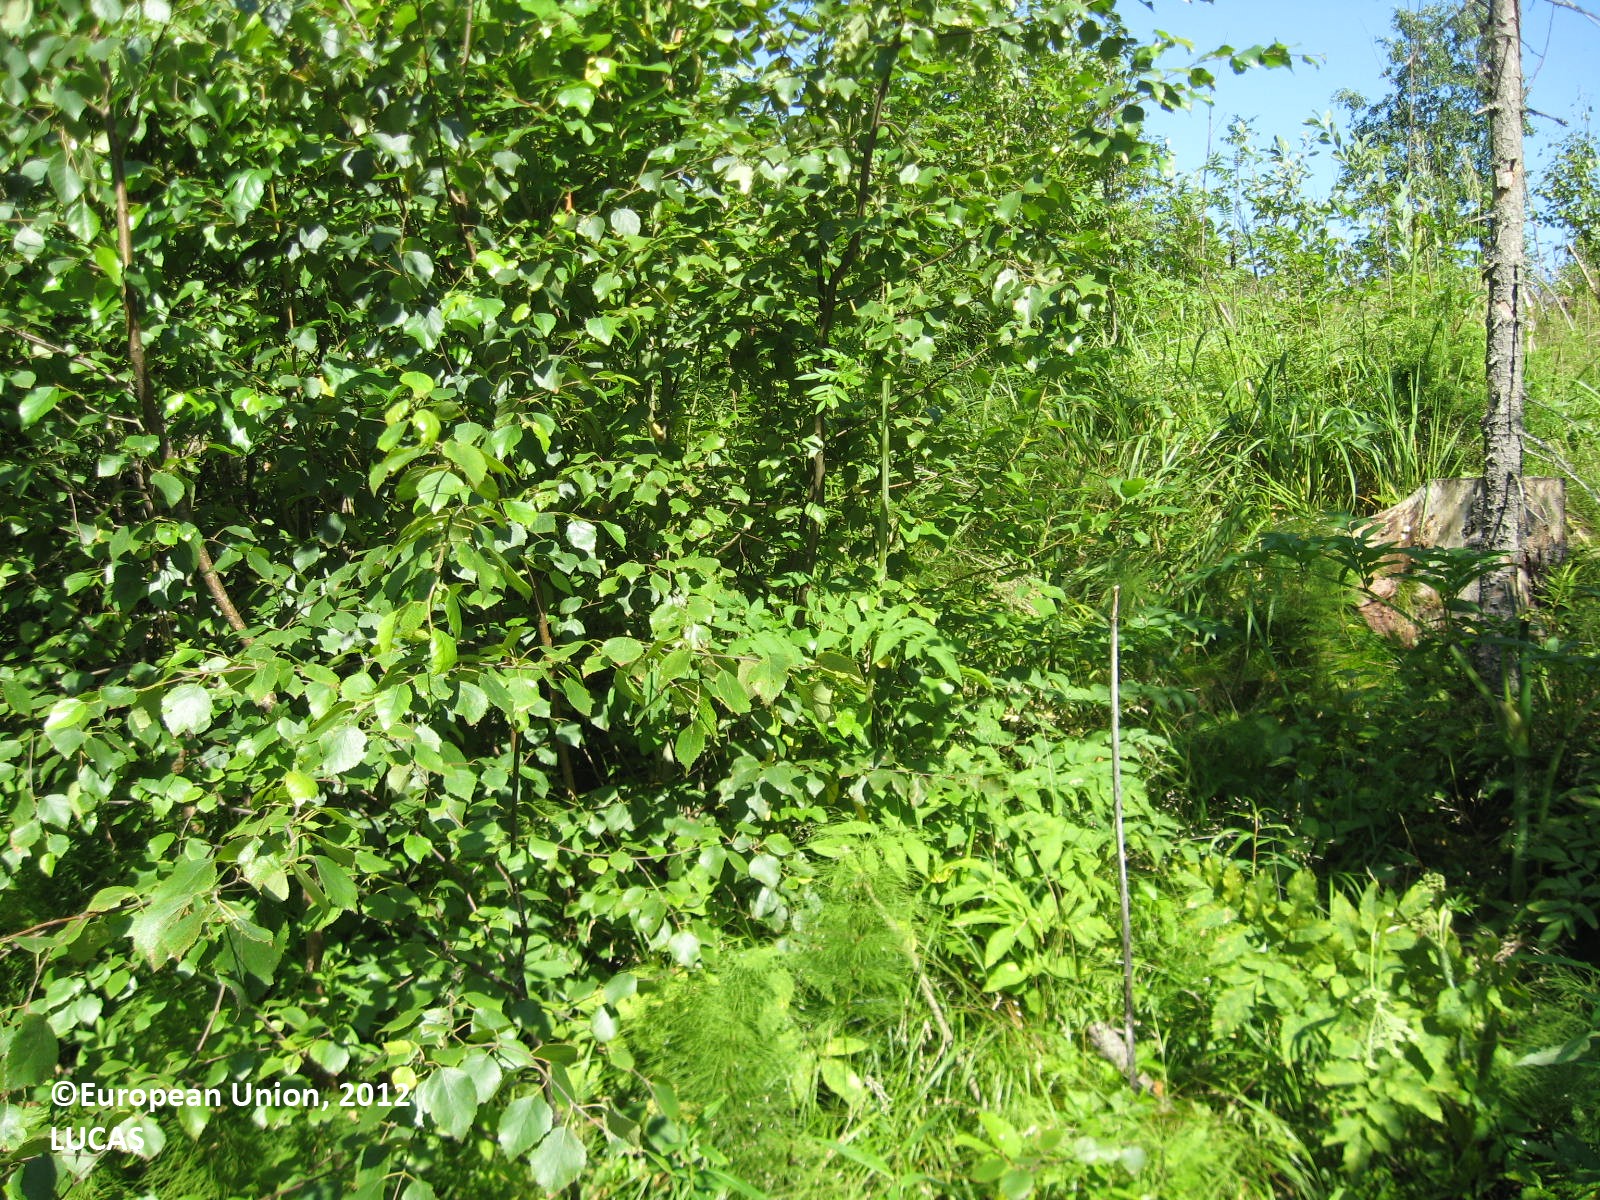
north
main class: Woodland
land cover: Other mixed woodland
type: boreal forest
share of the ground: > 75 %
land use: Forestry
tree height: > 5 m
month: July
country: FI
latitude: 61.9277
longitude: 22.8857
